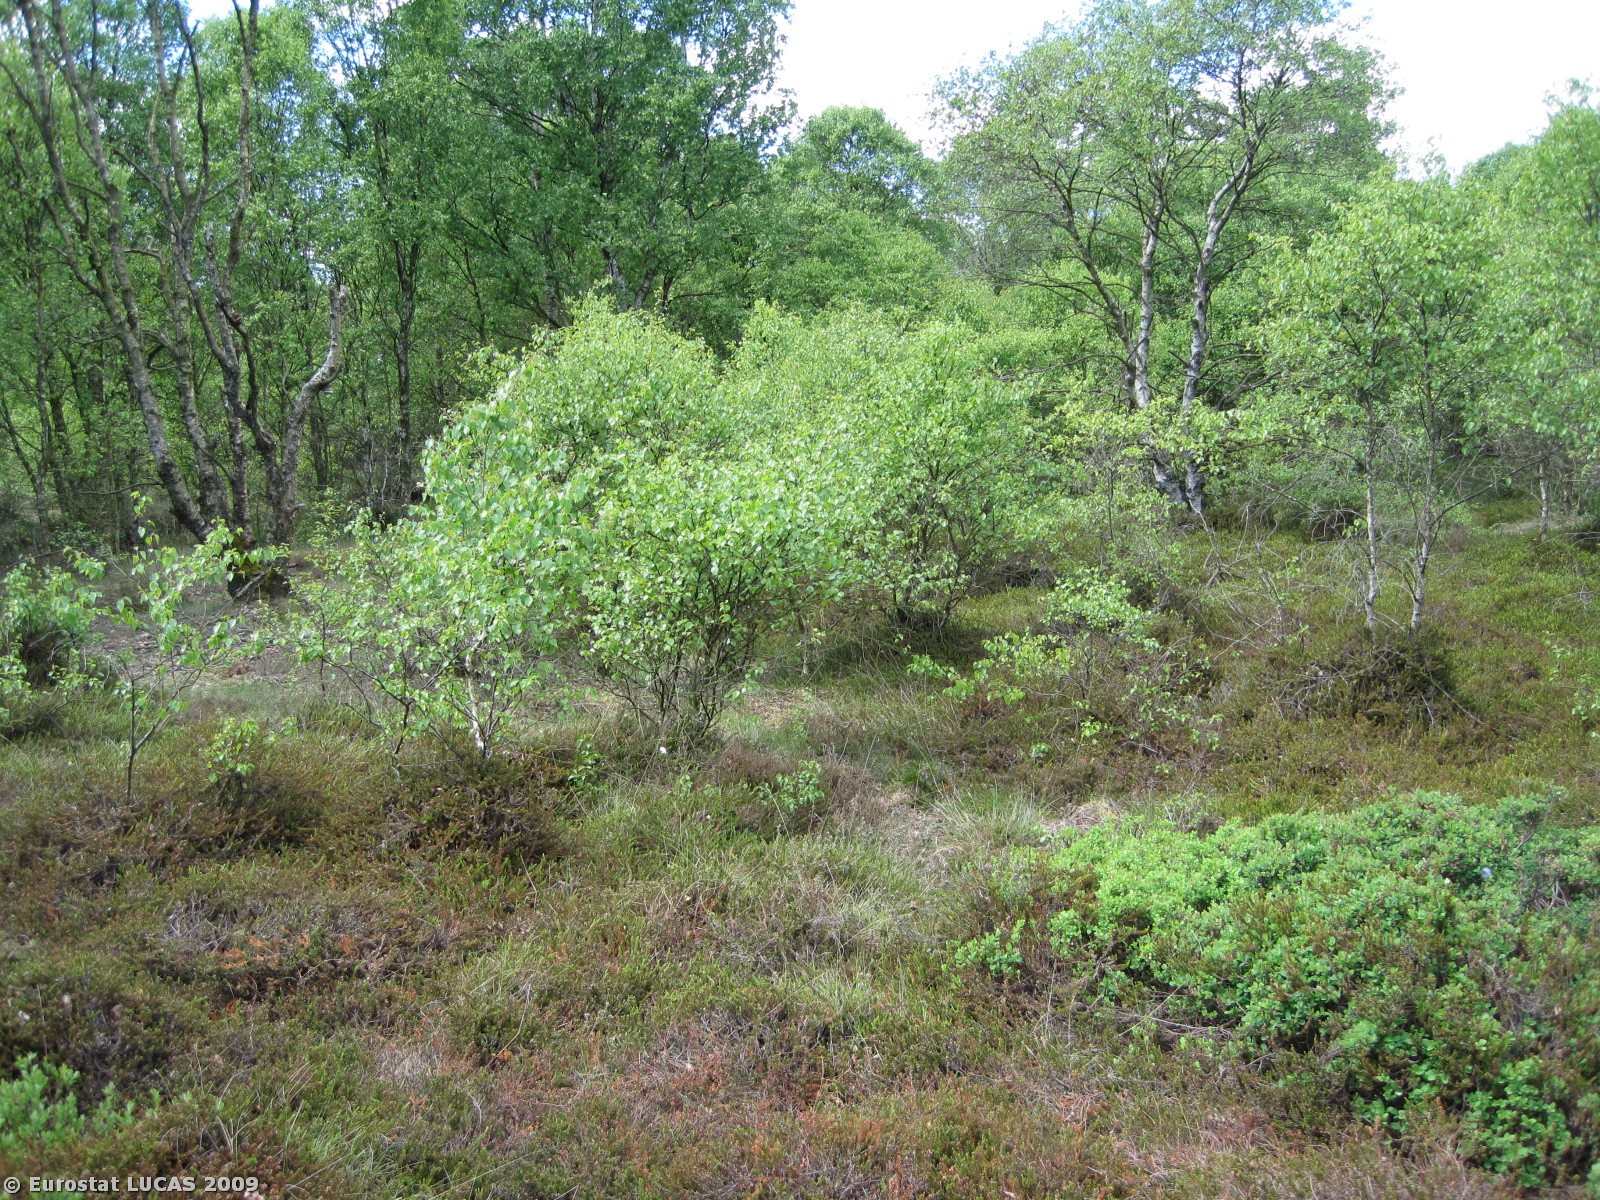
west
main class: Shrubland
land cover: Shrubland with sparse tree cover
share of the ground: > 75 %
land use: Unused
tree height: > 5 m
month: May
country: DK
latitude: 56.8887
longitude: 10.1803
